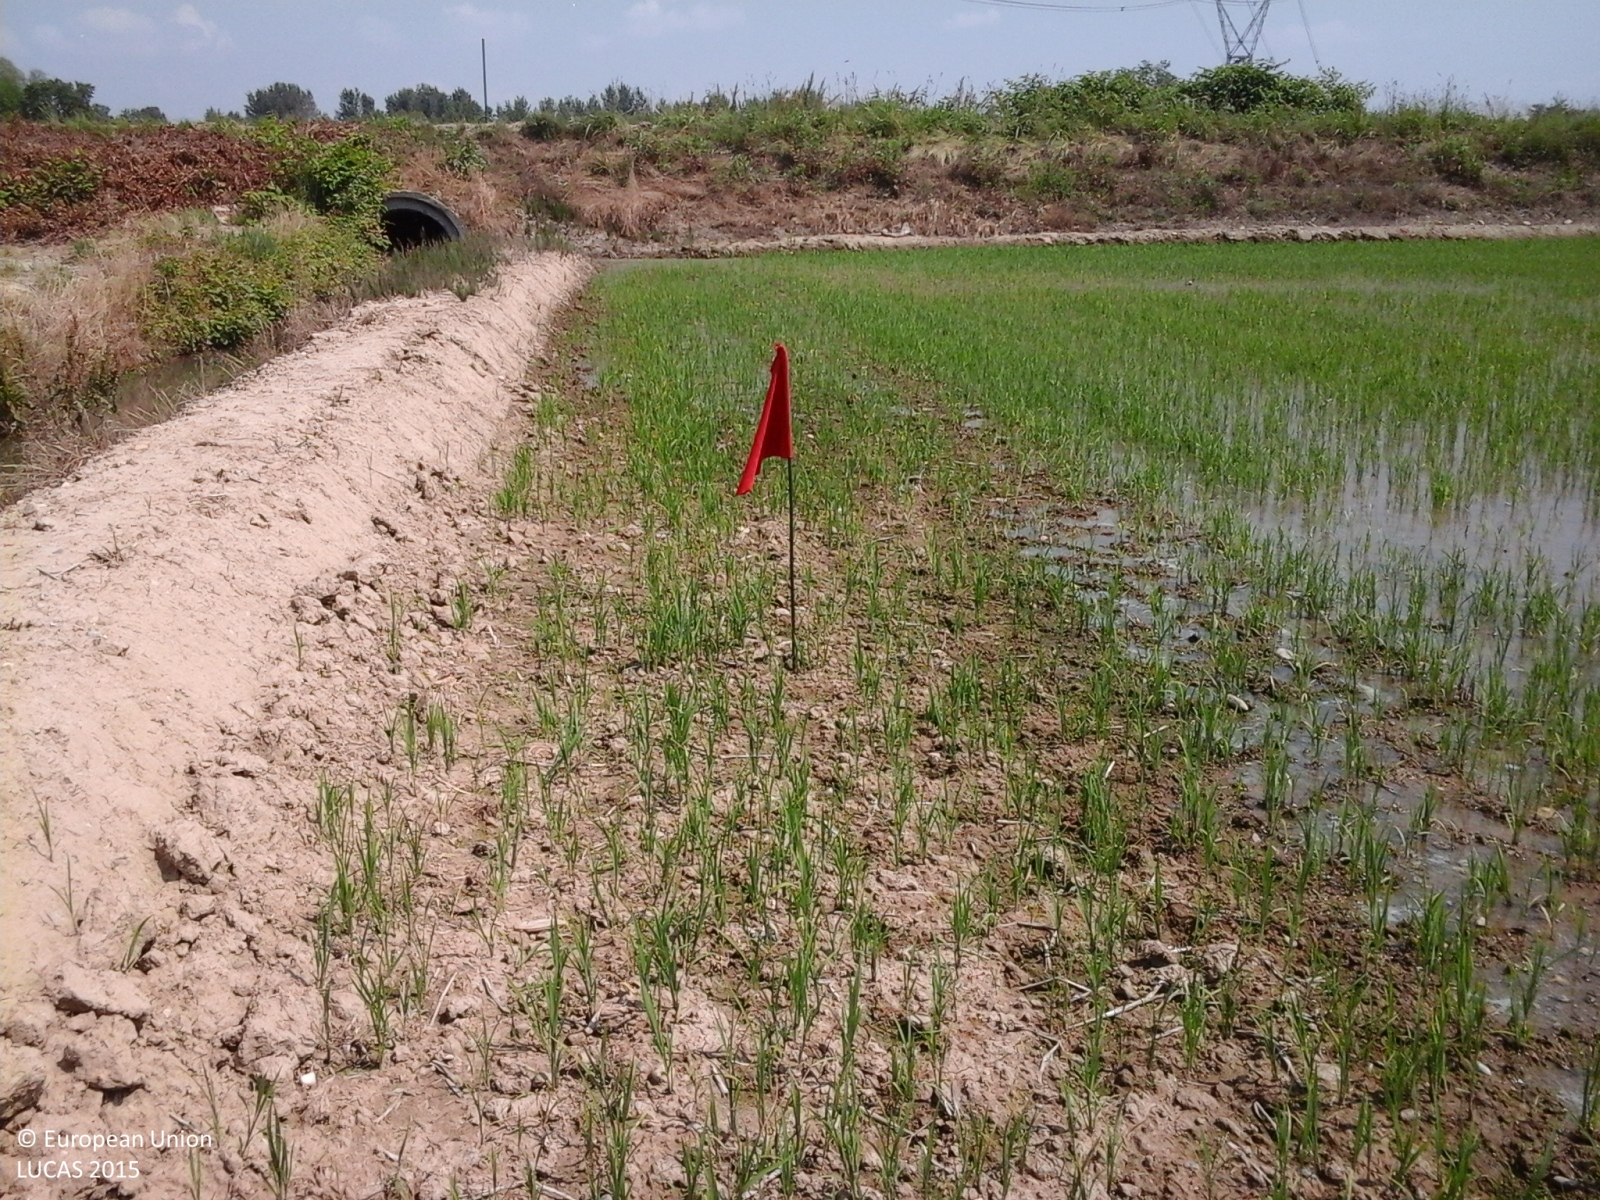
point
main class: Cropland
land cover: Rice
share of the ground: 25 - 50 %
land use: Agriculture (excluding fallow land and kitchen gardens)
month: May
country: IT
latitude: 45.4170
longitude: 8.2012
